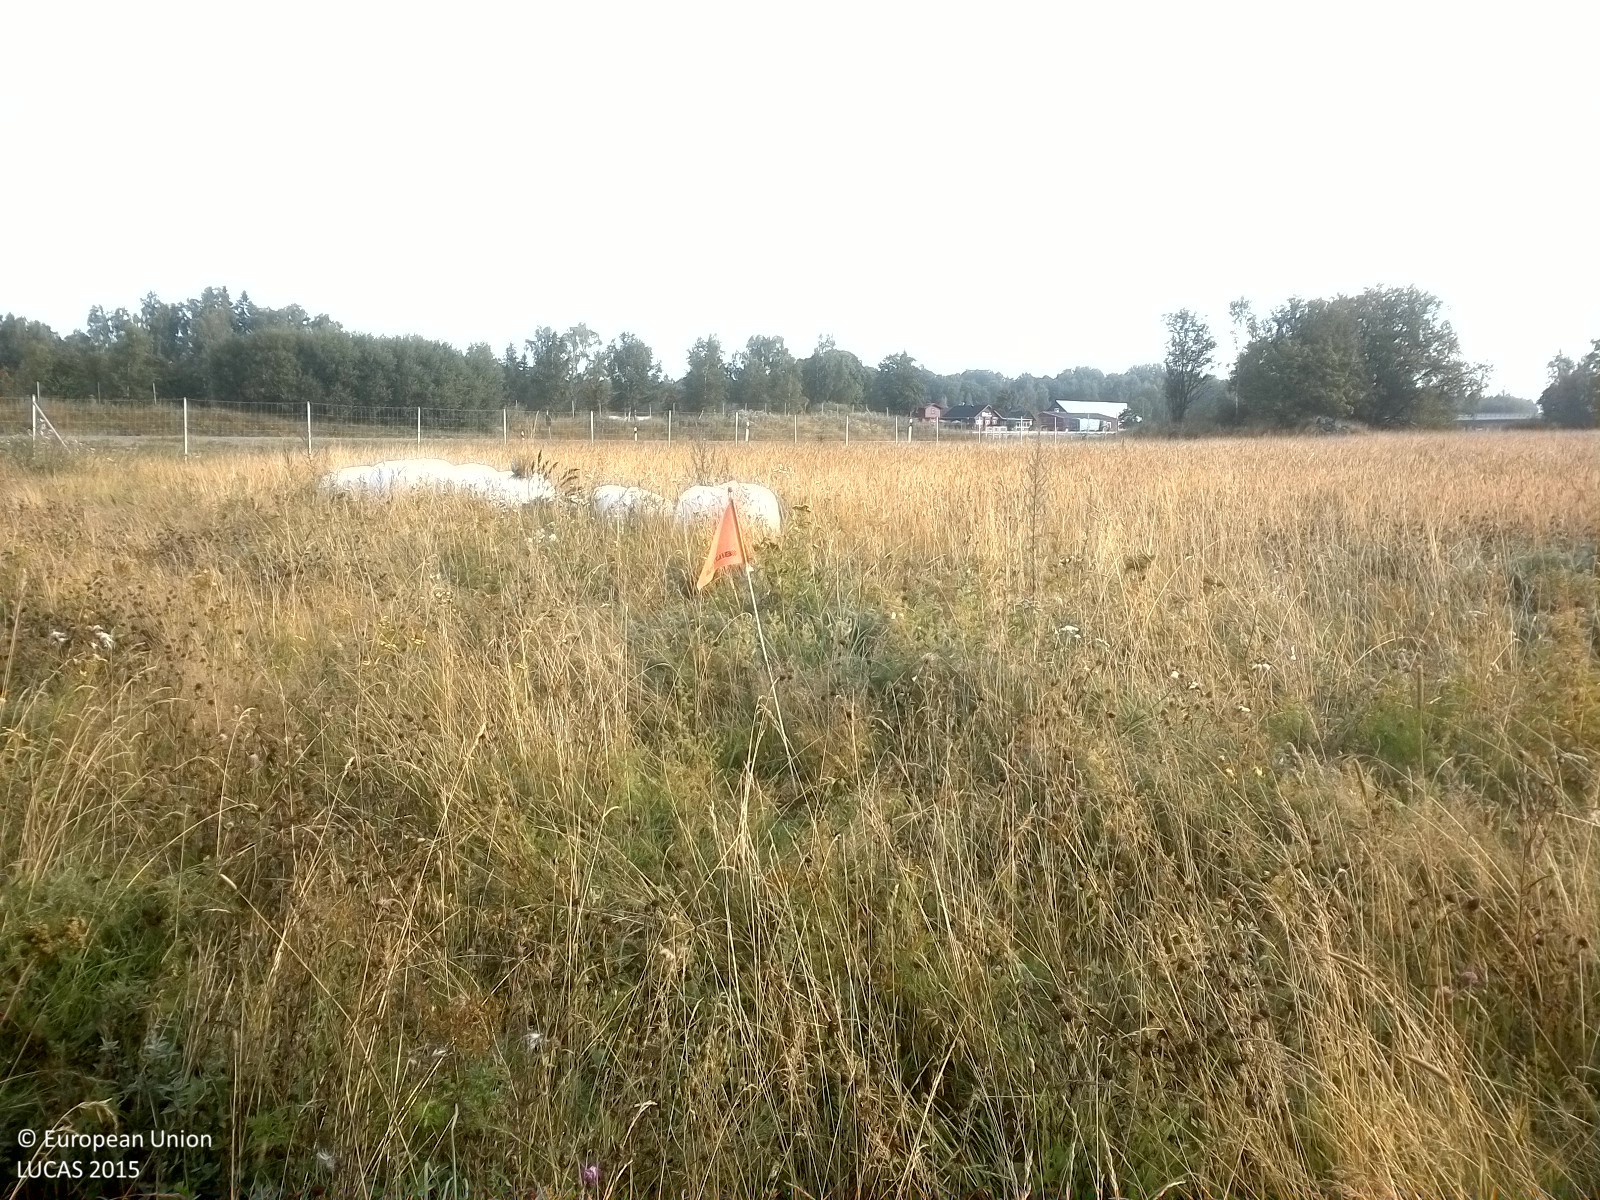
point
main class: Grassland
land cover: Spontaneously vegetated surfaces
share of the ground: > 75 %
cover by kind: herbaceous plants 100 %
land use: Fallow land
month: August
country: SE
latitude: 59.3324
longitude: 15.5285
